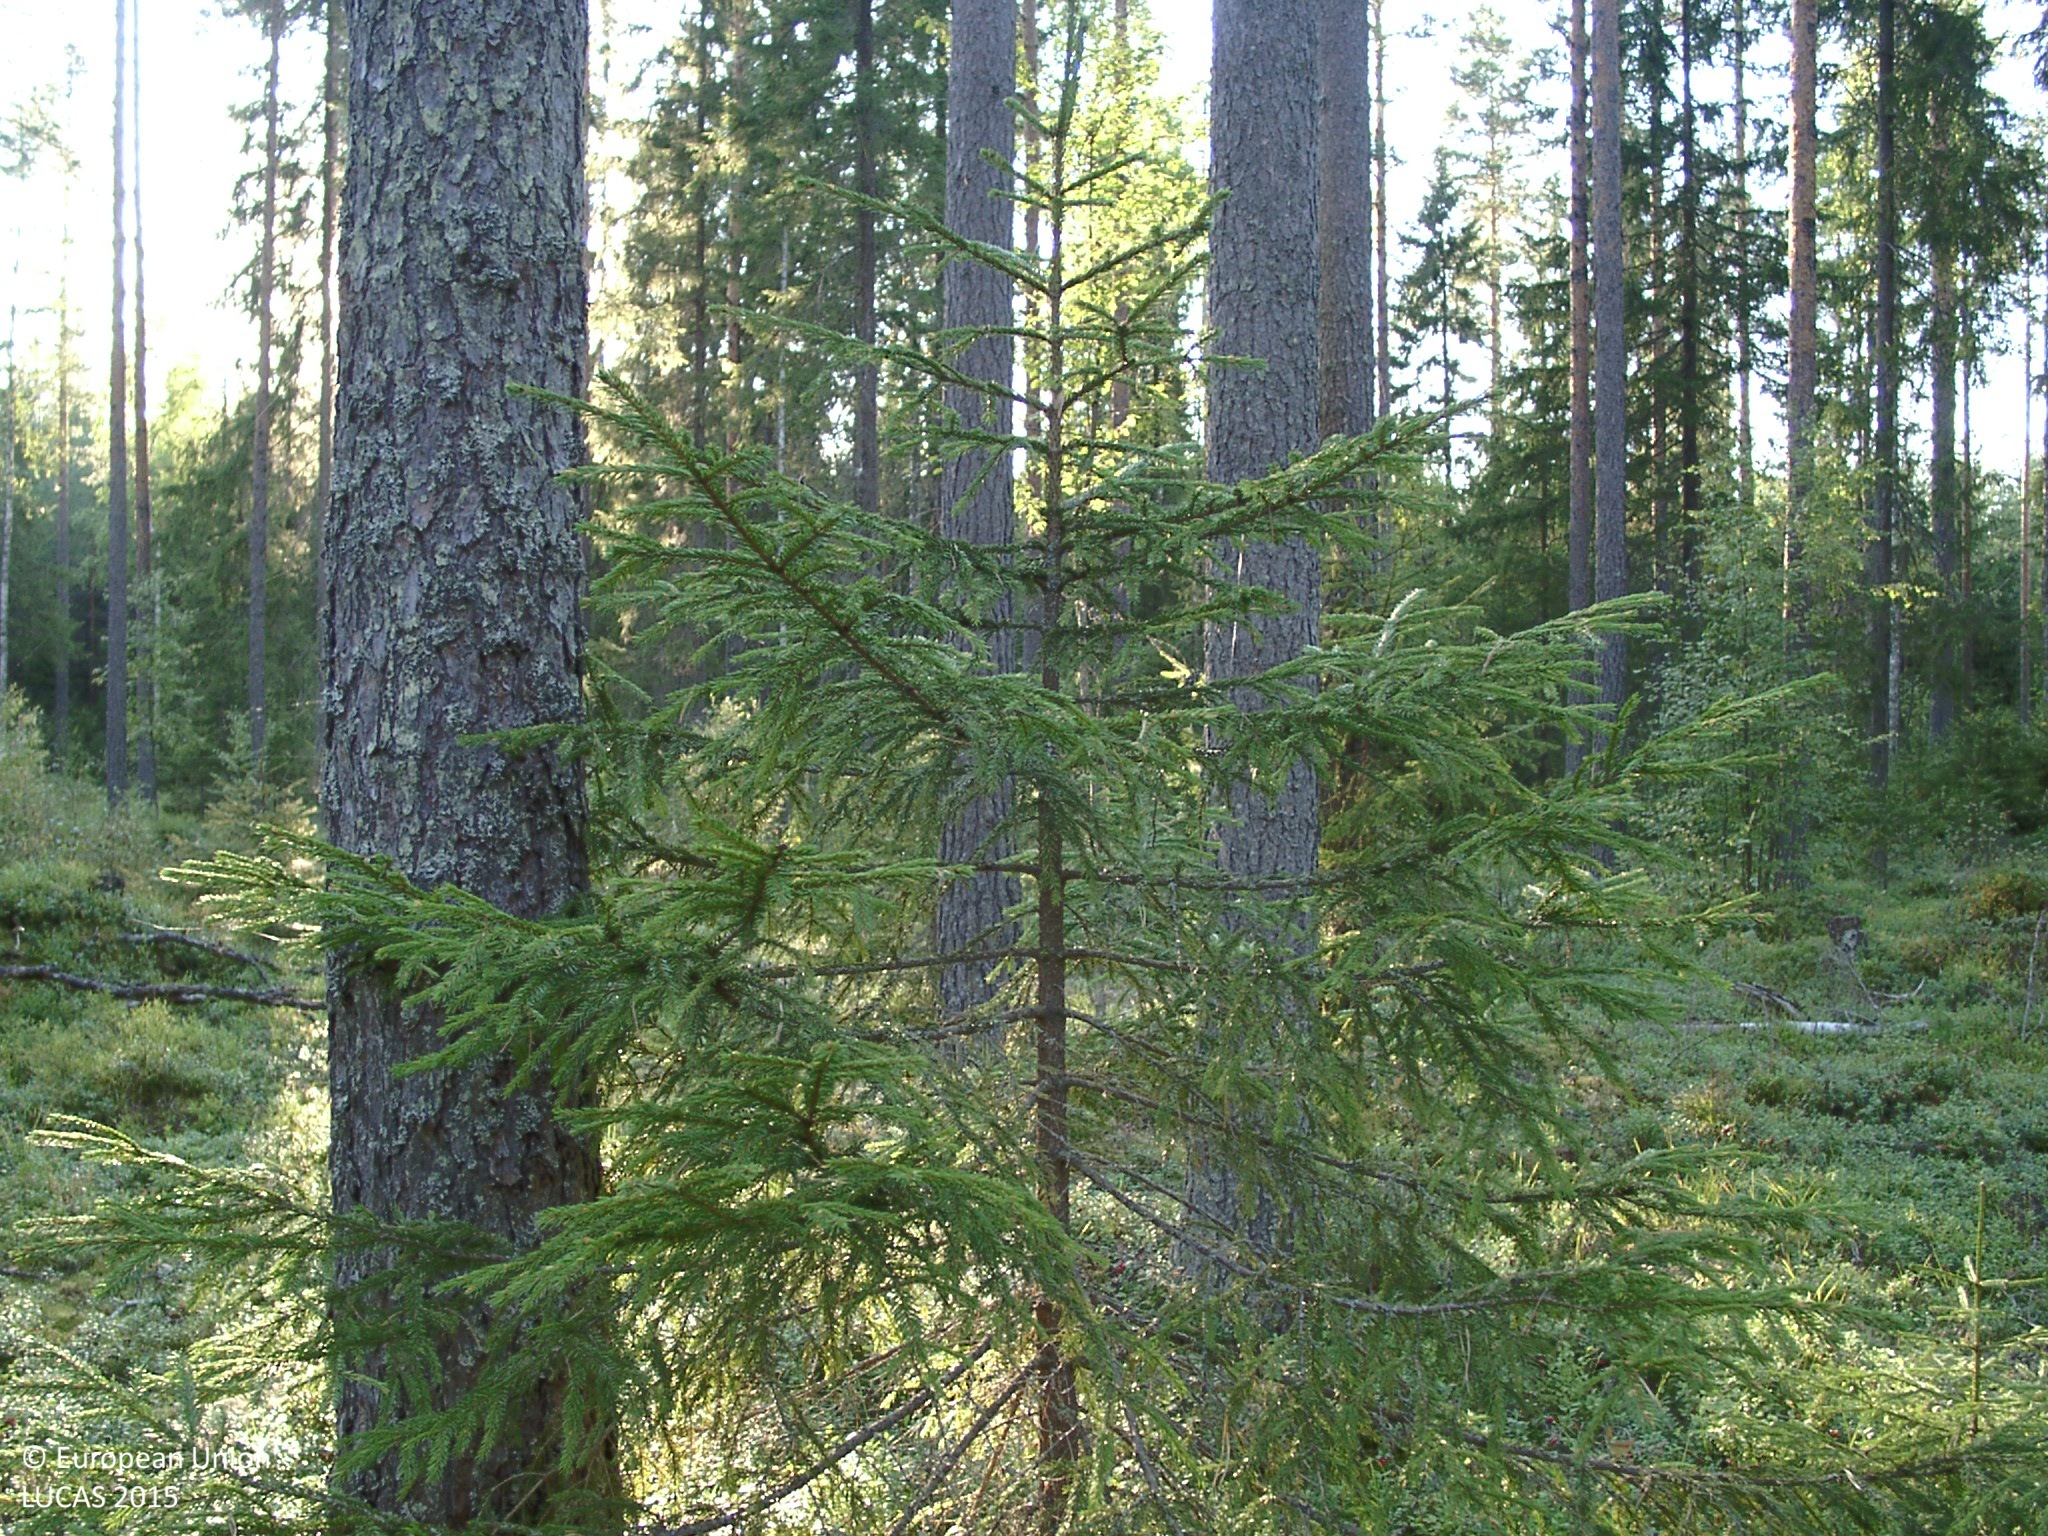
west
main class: Woodland
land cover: Pine dominated coniferous woodland
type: boreal forest
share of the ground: 50 - 75 %
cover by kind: coniferous forest trees 55 %, shrubs 30 %, lichens and mosses 10 %, broadleaved forest trees 5 %
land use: Forestry
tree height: > 5 m
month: August
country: FI
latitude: 61.9361
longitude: 25.1033
